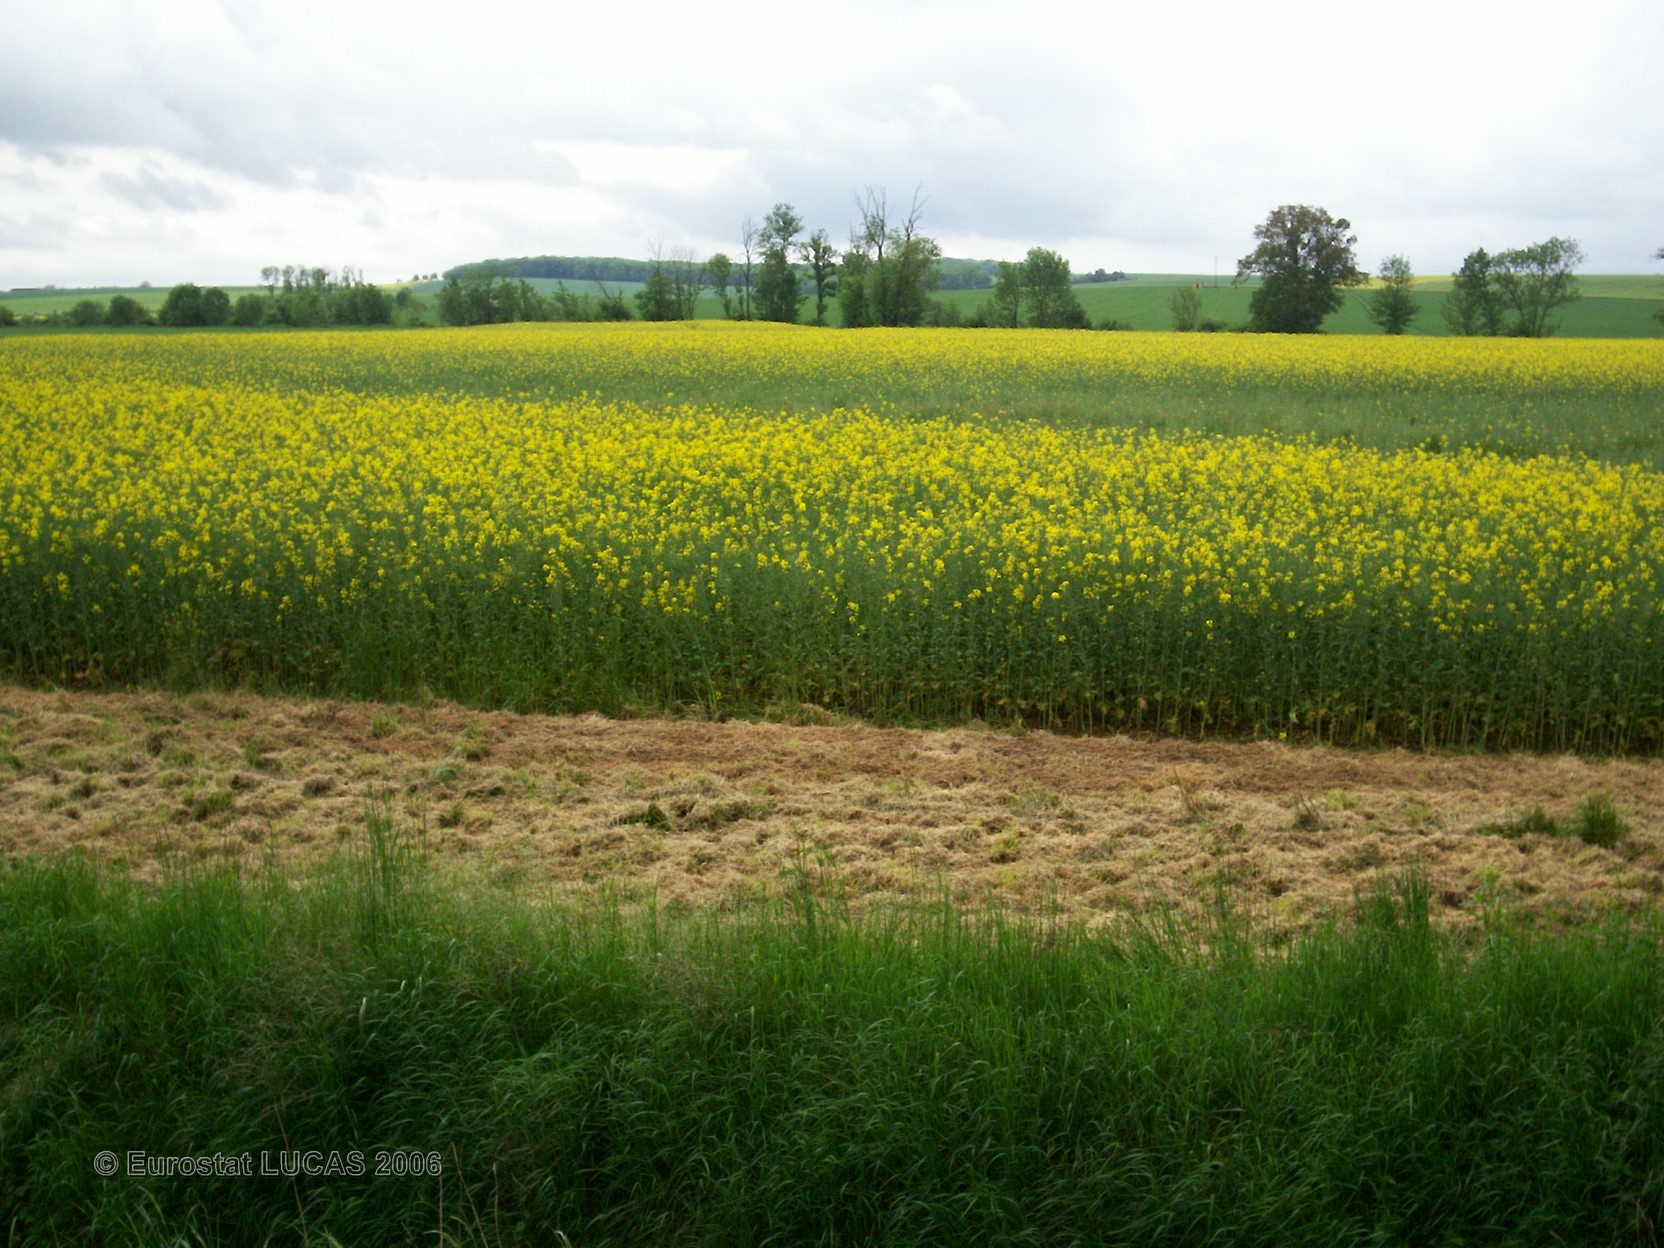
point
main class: Cropland
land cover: Rape and turnip rape
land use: Agriculture (excluding fallow land and kitchen gardens)
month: May
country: FR
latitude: 48.2301
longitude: 4.4915
